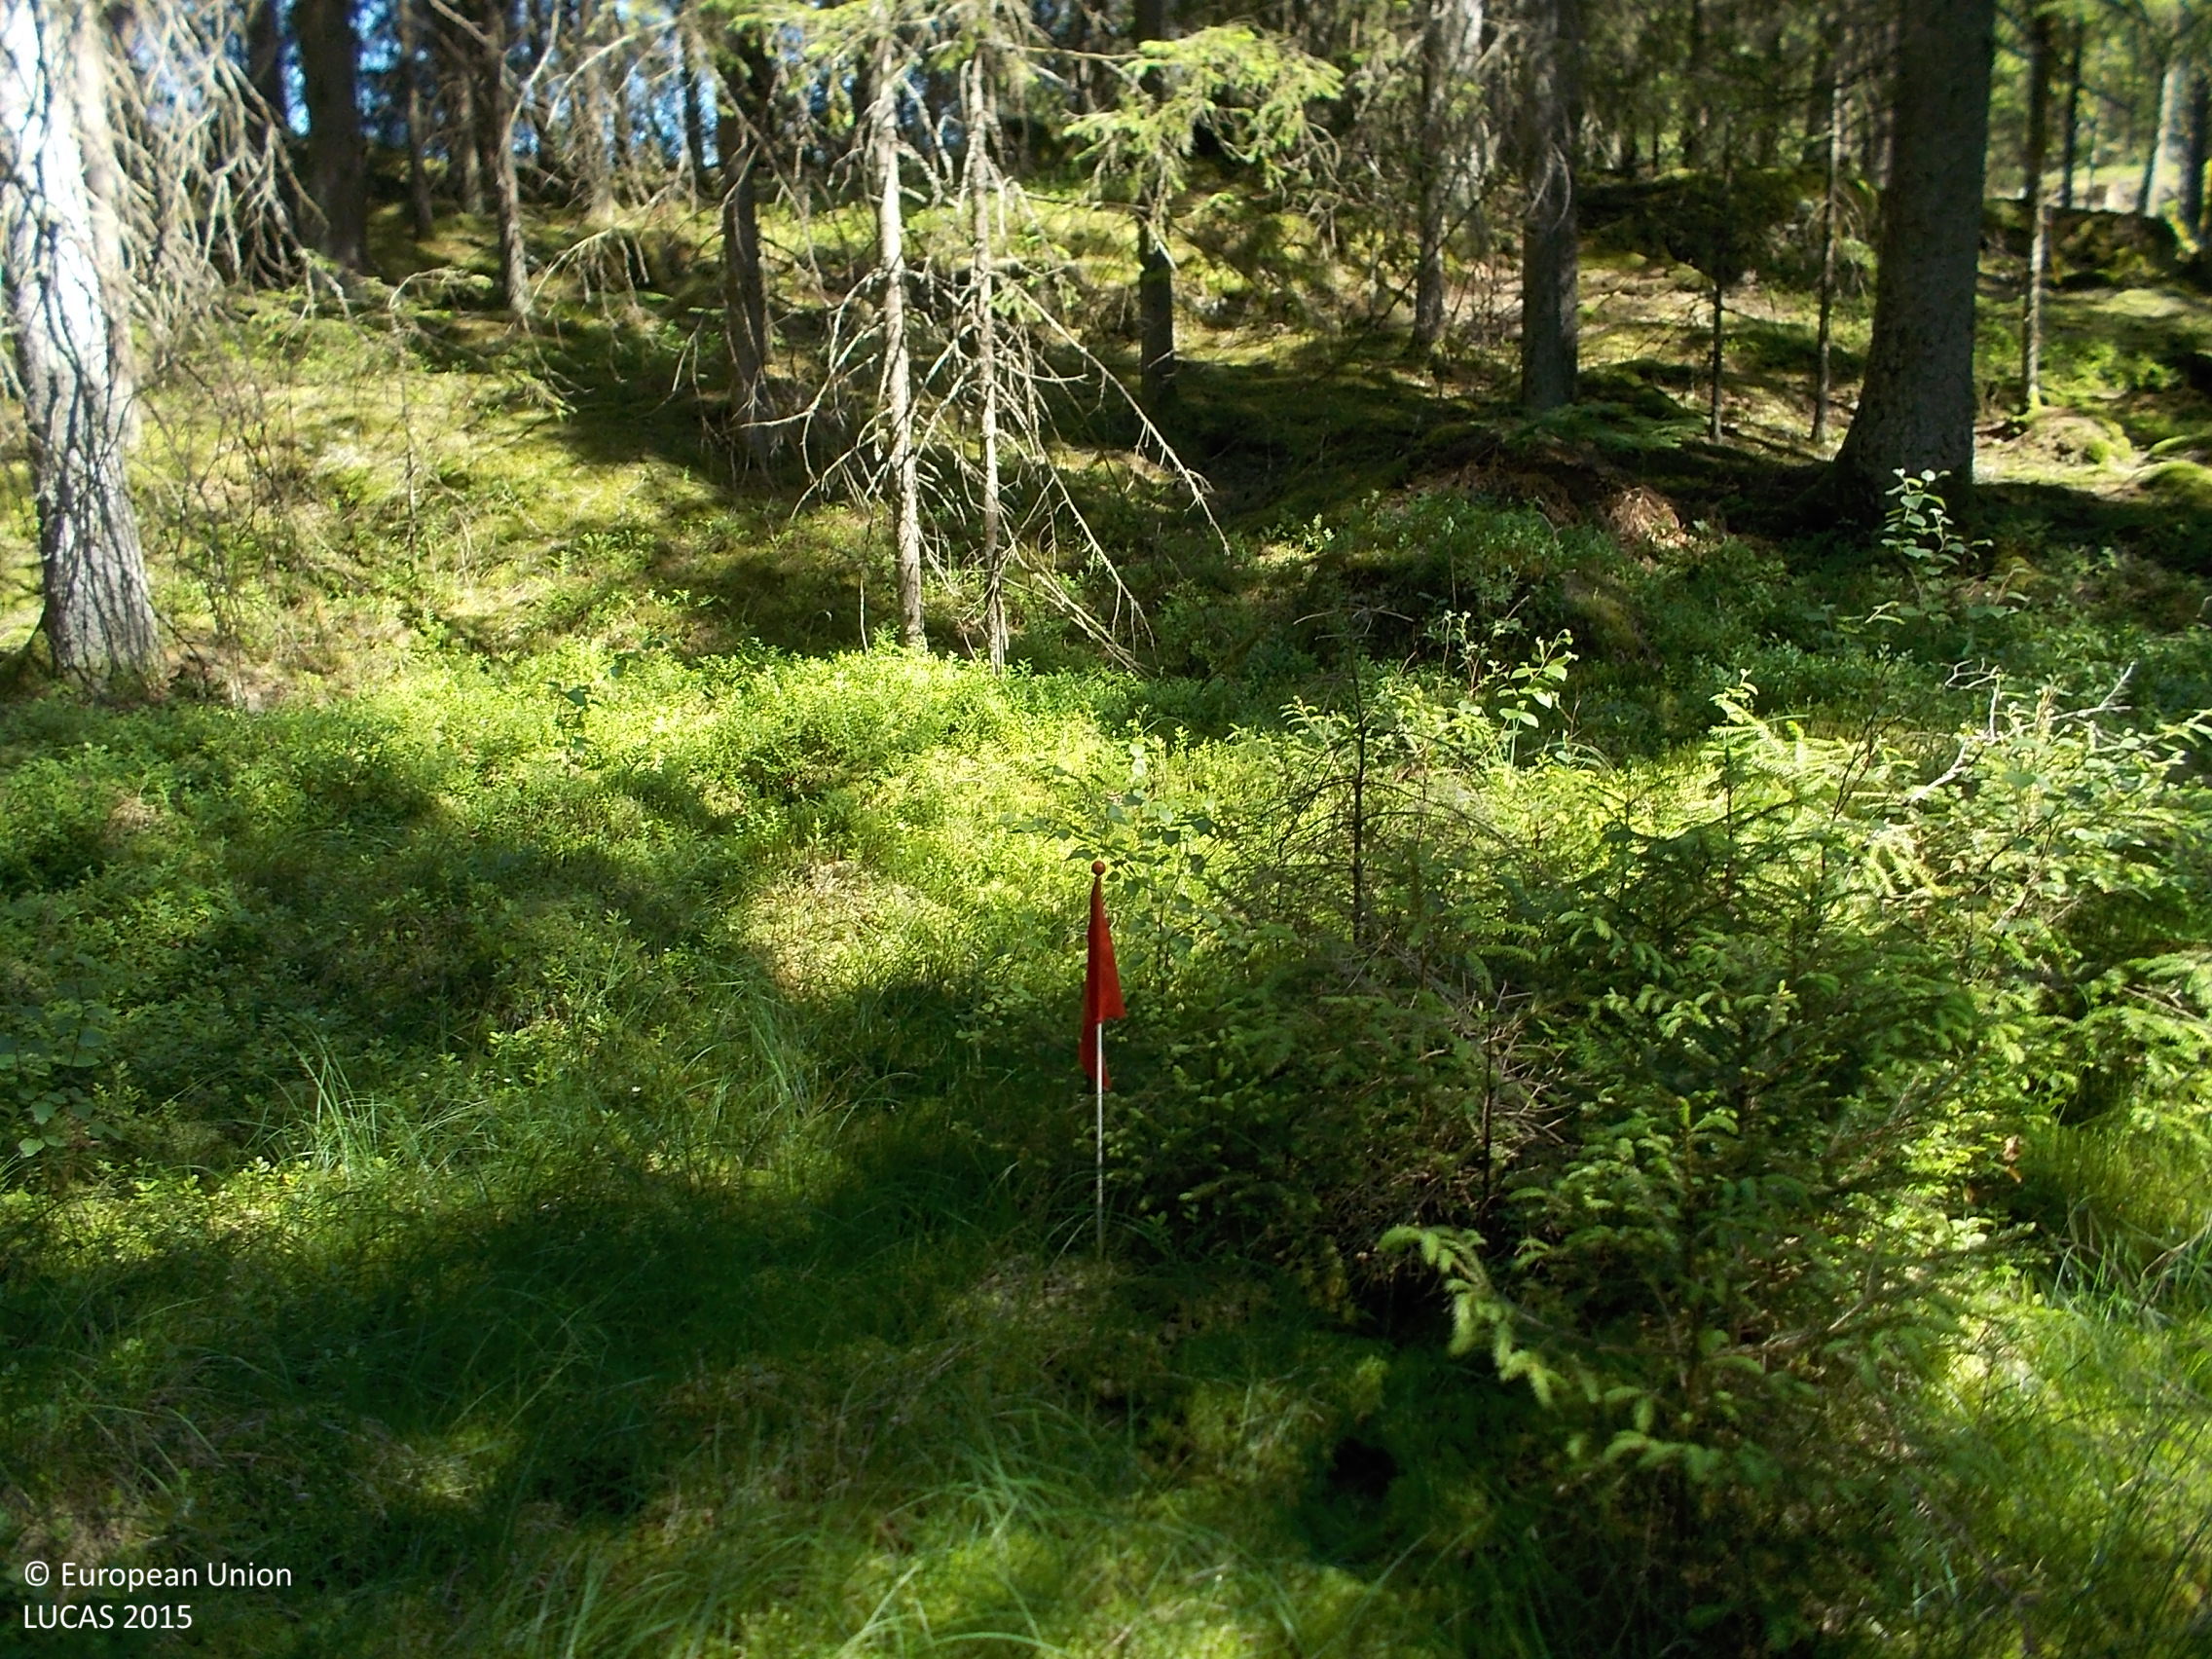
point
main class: Woodland
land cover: Spruce dominated coniferous woodland
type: mire and swamp forests
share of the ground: 50 - 75 %
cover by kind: coniferous forest trees 70 %, lichens and mosses 20 %, shrubs 5 %, herbaceous plants 5 %
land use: Forestry
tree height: > 5 m
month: July
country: SE
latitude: 57.3167
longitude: 13.2337
